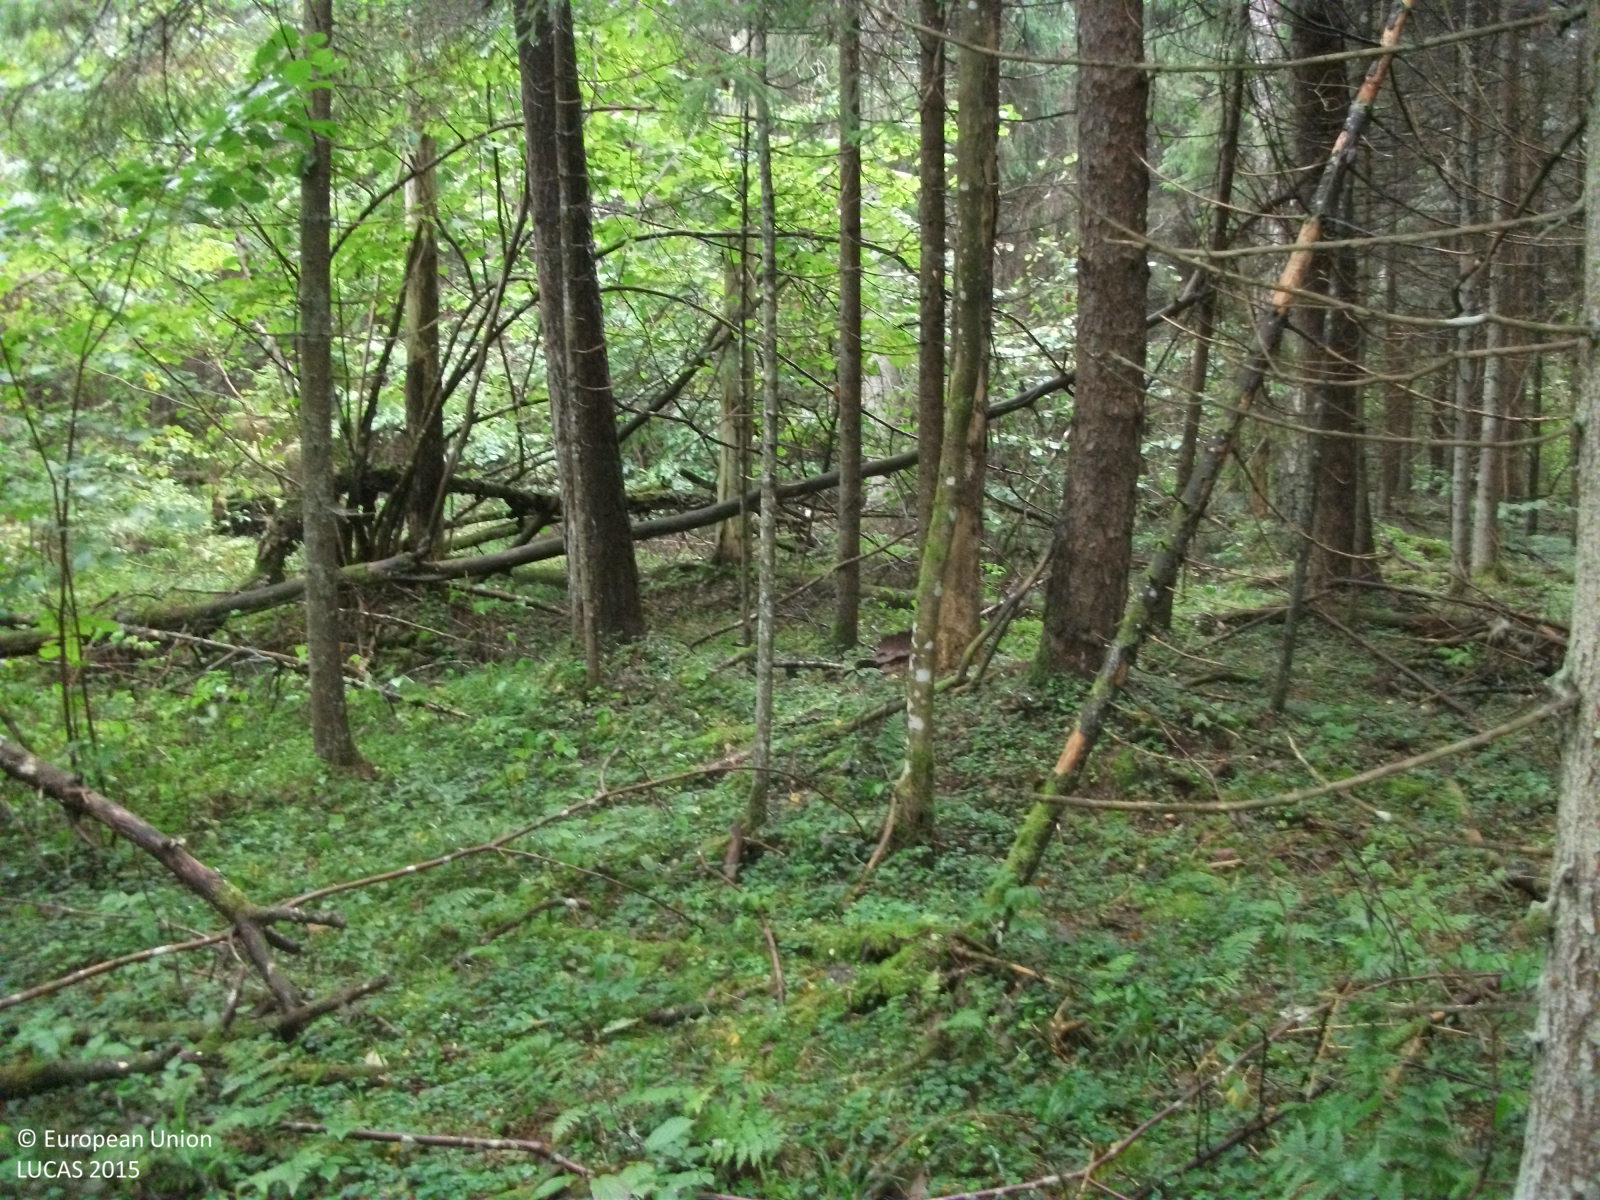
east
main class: Woodland
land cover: Spruce dominated coniferous woodland
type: hemiboreal forest and nemoral coniferous forest and mixed broadleaved-coniferous forest
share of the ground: > 75 %
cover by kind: coniferous forest trees 80 %, broadleaved forest trees 10 %, shrubs 5 %, herbaceous plants 5 %
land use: Forestry
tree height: > 5 m
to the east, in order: Spruce dominated coniferous woodland; Spruce dominated mixed woodland; Spontaneously vegetated surfaces; Ditches and canals; Spruce dominated mixed woodland; Spruce dominated coniferous woodland
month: September
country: LV
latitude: 57.5984
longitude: 24.7709
